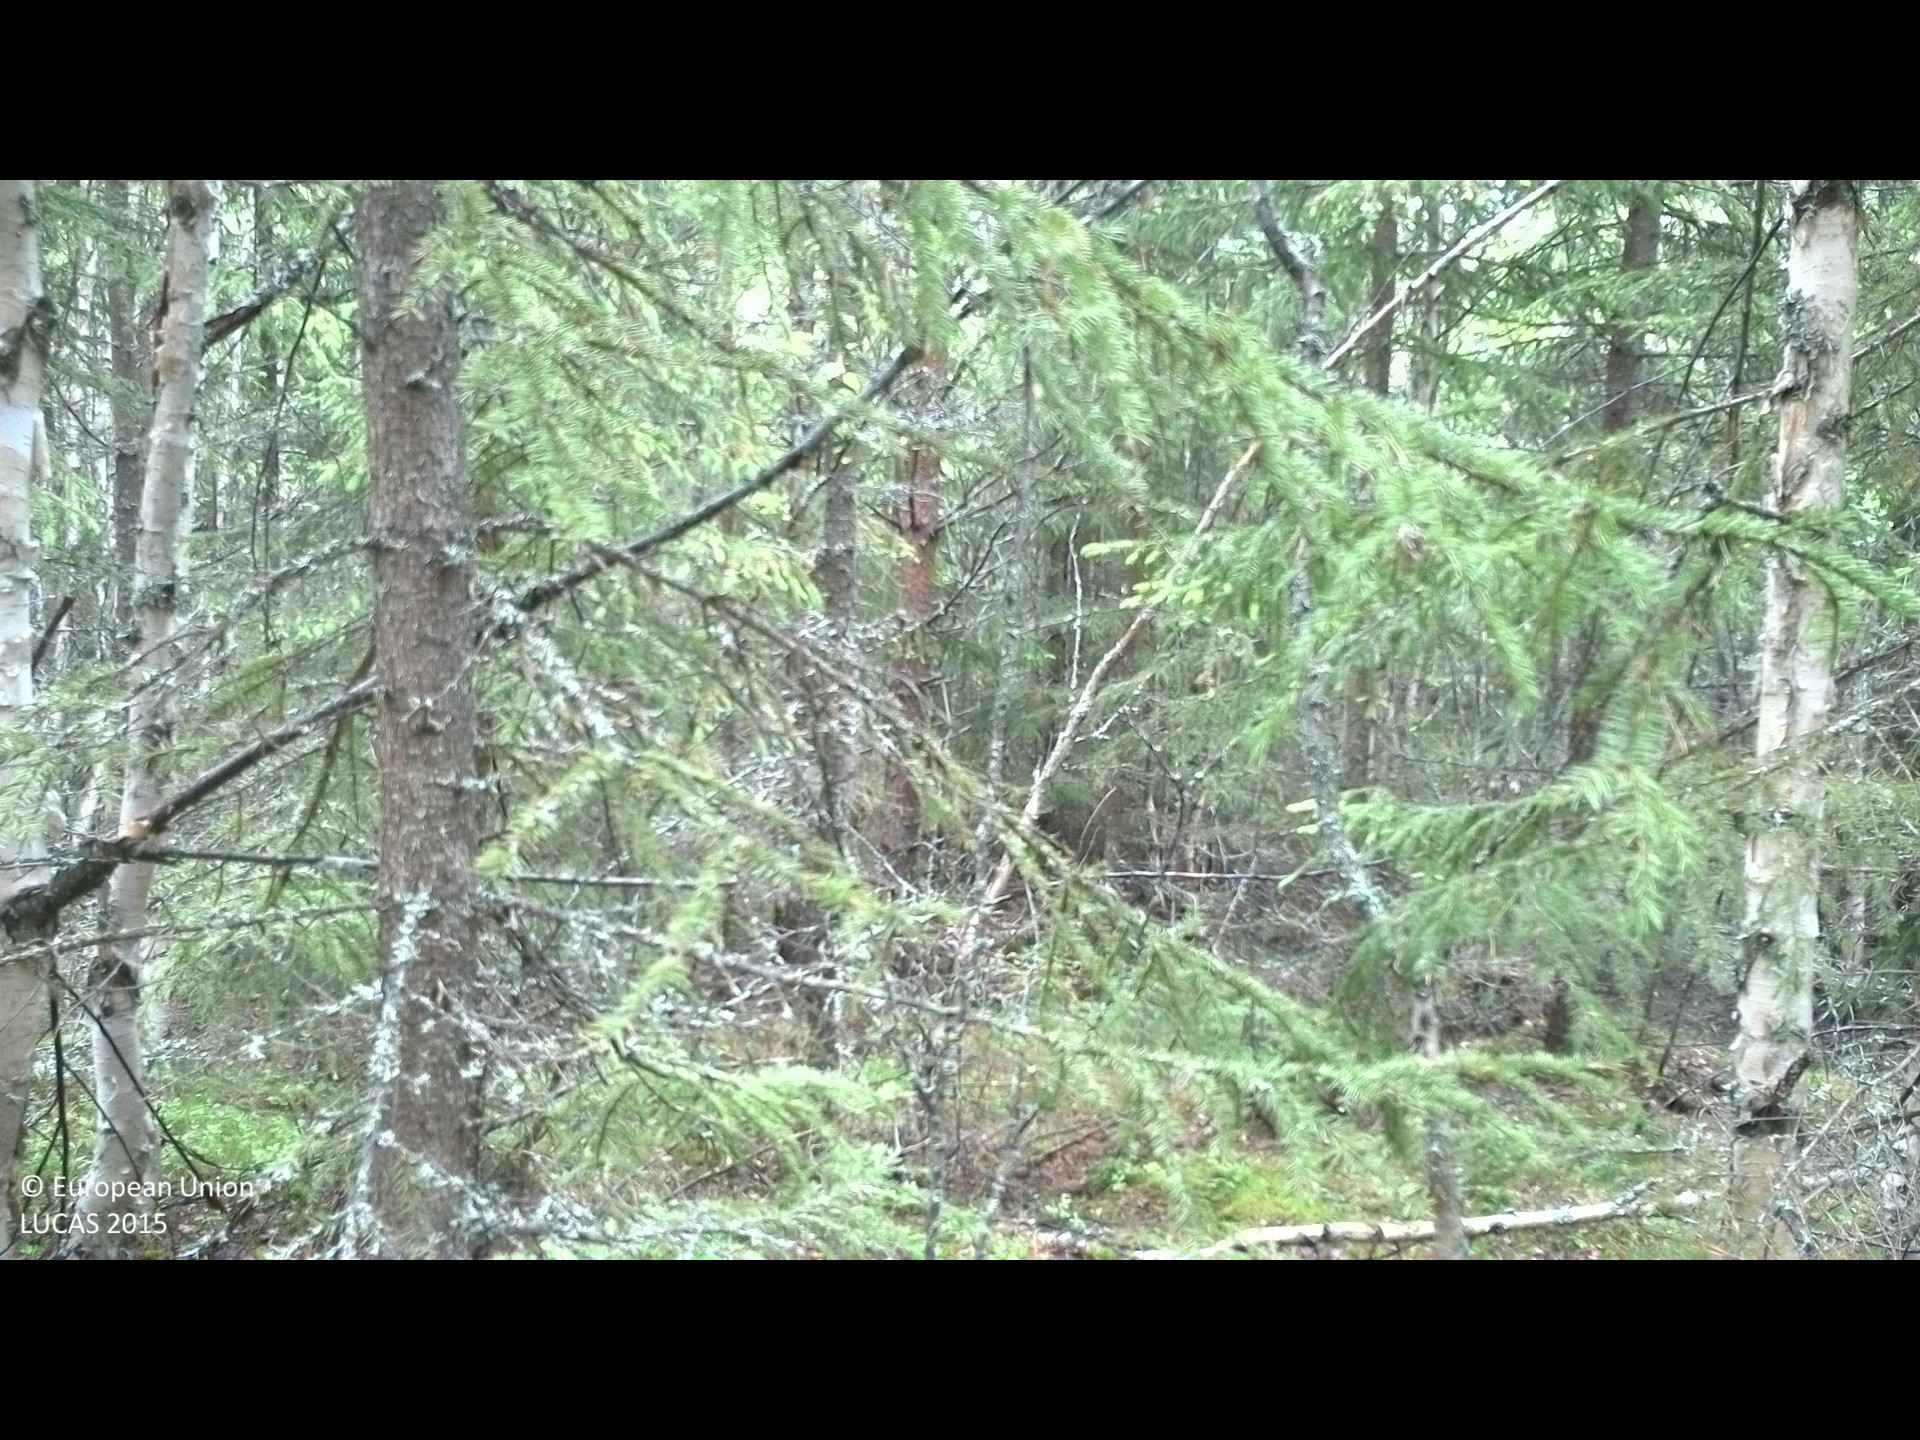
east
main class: Woodland
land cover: Spruce dominated coniferous woodland
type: boreal forest
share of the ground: > 75 %
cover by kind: coniferous forest trees 60 %, broadleaved forest trees 15 %, lichens and mosses 15 %, herbaceous plants 10 %
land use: Forestry
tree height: > 5 m
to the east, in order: Spruce dominated coniferous woodland; Ditches and canals; Spruce dominated mixed woodland; Ditches and canals; Spruce dominated mixed woodland; Pine dominated mixed woodland; Tracks; Spruce dominated coniferous woodland
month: June
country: SE
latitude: 61.9721
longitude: 16.7541
